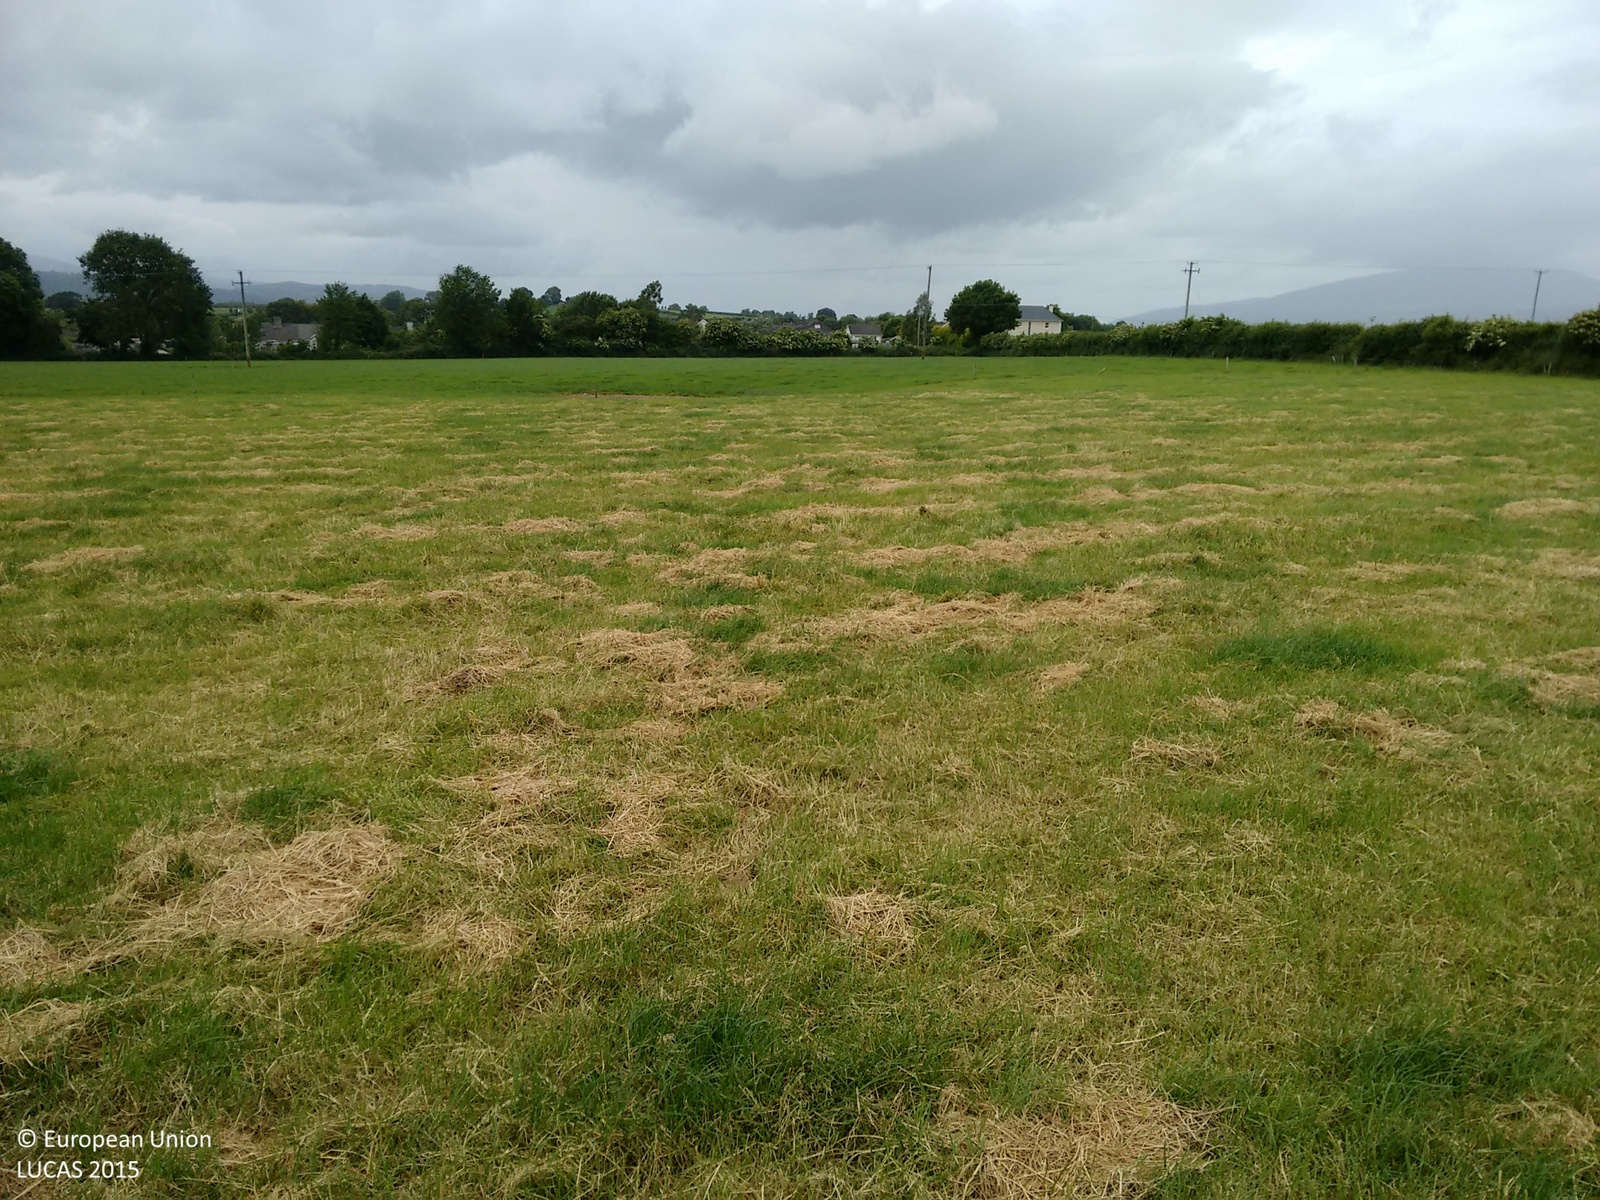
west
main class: Grassland
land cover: Grassland without tree/shrub cover
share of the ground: > 75 %
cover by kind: herbaceous plants 100 %
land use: Agriculture (excluding fallow land and kitchen gardens)
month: June
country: IE
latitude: 52.3653
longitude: -7.4120
